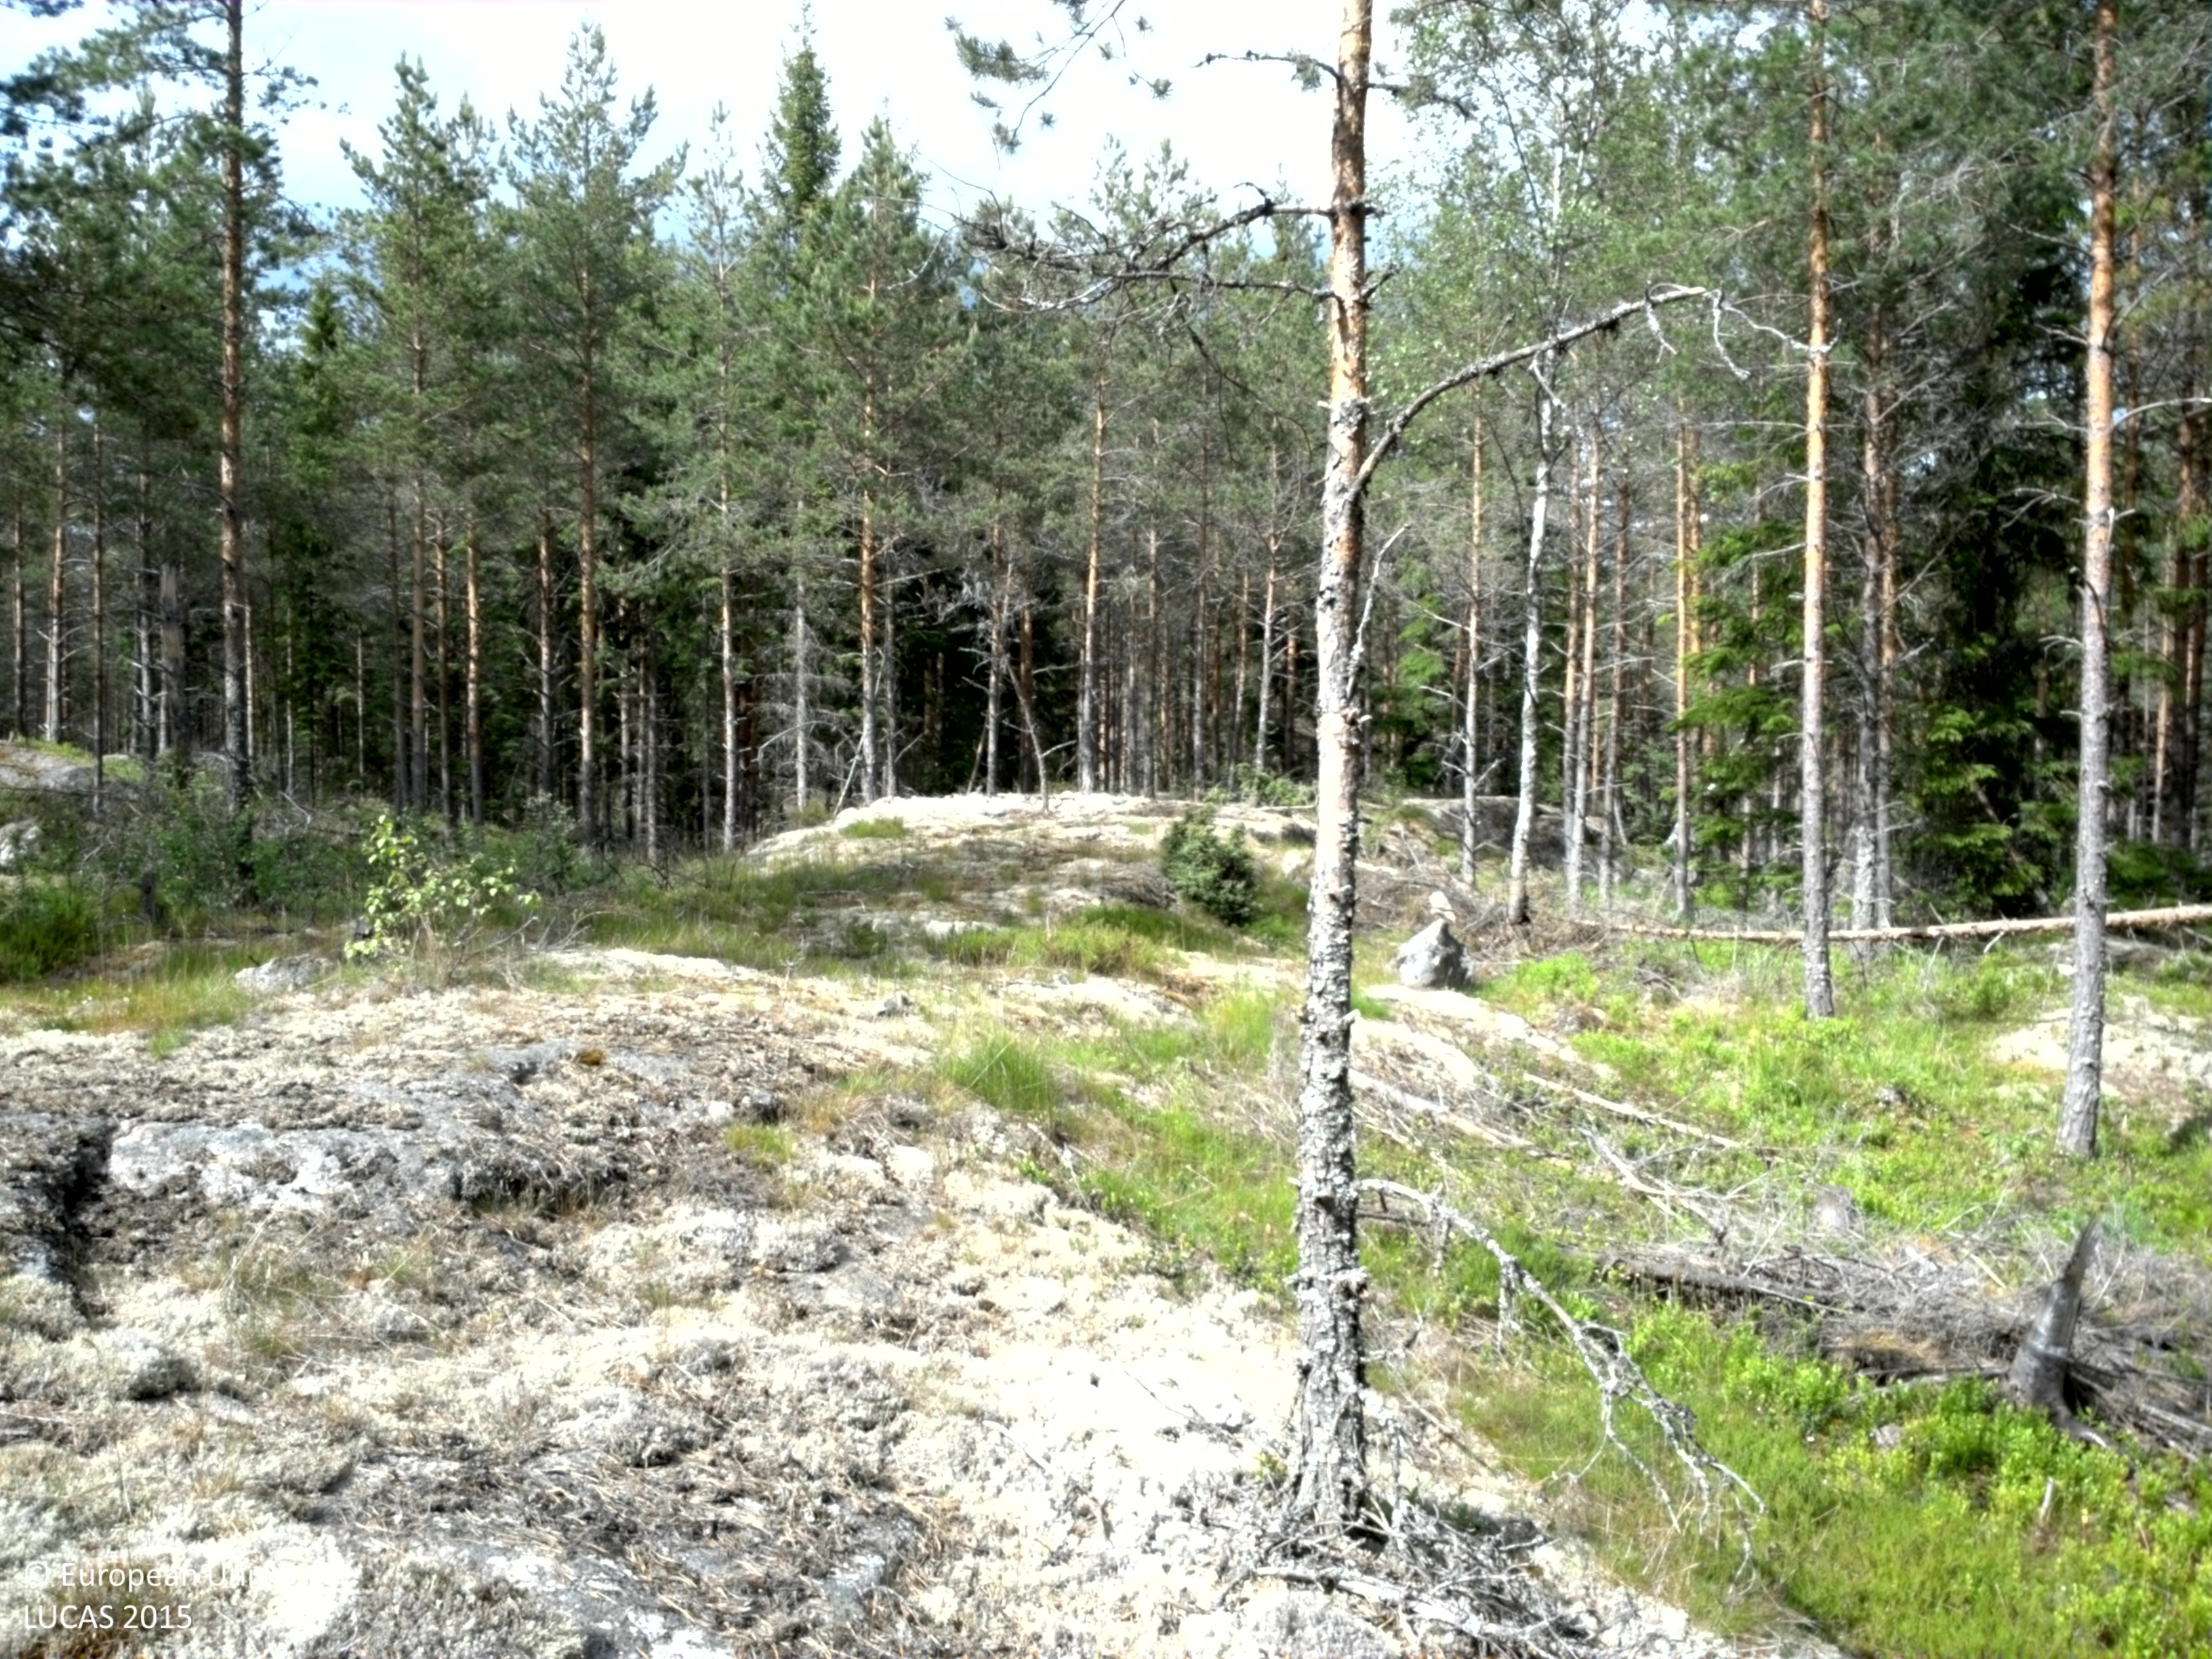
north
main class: Woodland
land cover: Pine dominated coniferous woodland
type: boreal forest
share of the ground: 50 - 75 %
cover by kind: coniferous forest trees 45 %, herbaceous plants 30 %, lichens and mosses 20 %, broadleaved forest trees 5 %
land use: Forestry
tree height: > 5 m
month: June
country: SE
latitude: 59.9619
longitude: 17.1741
